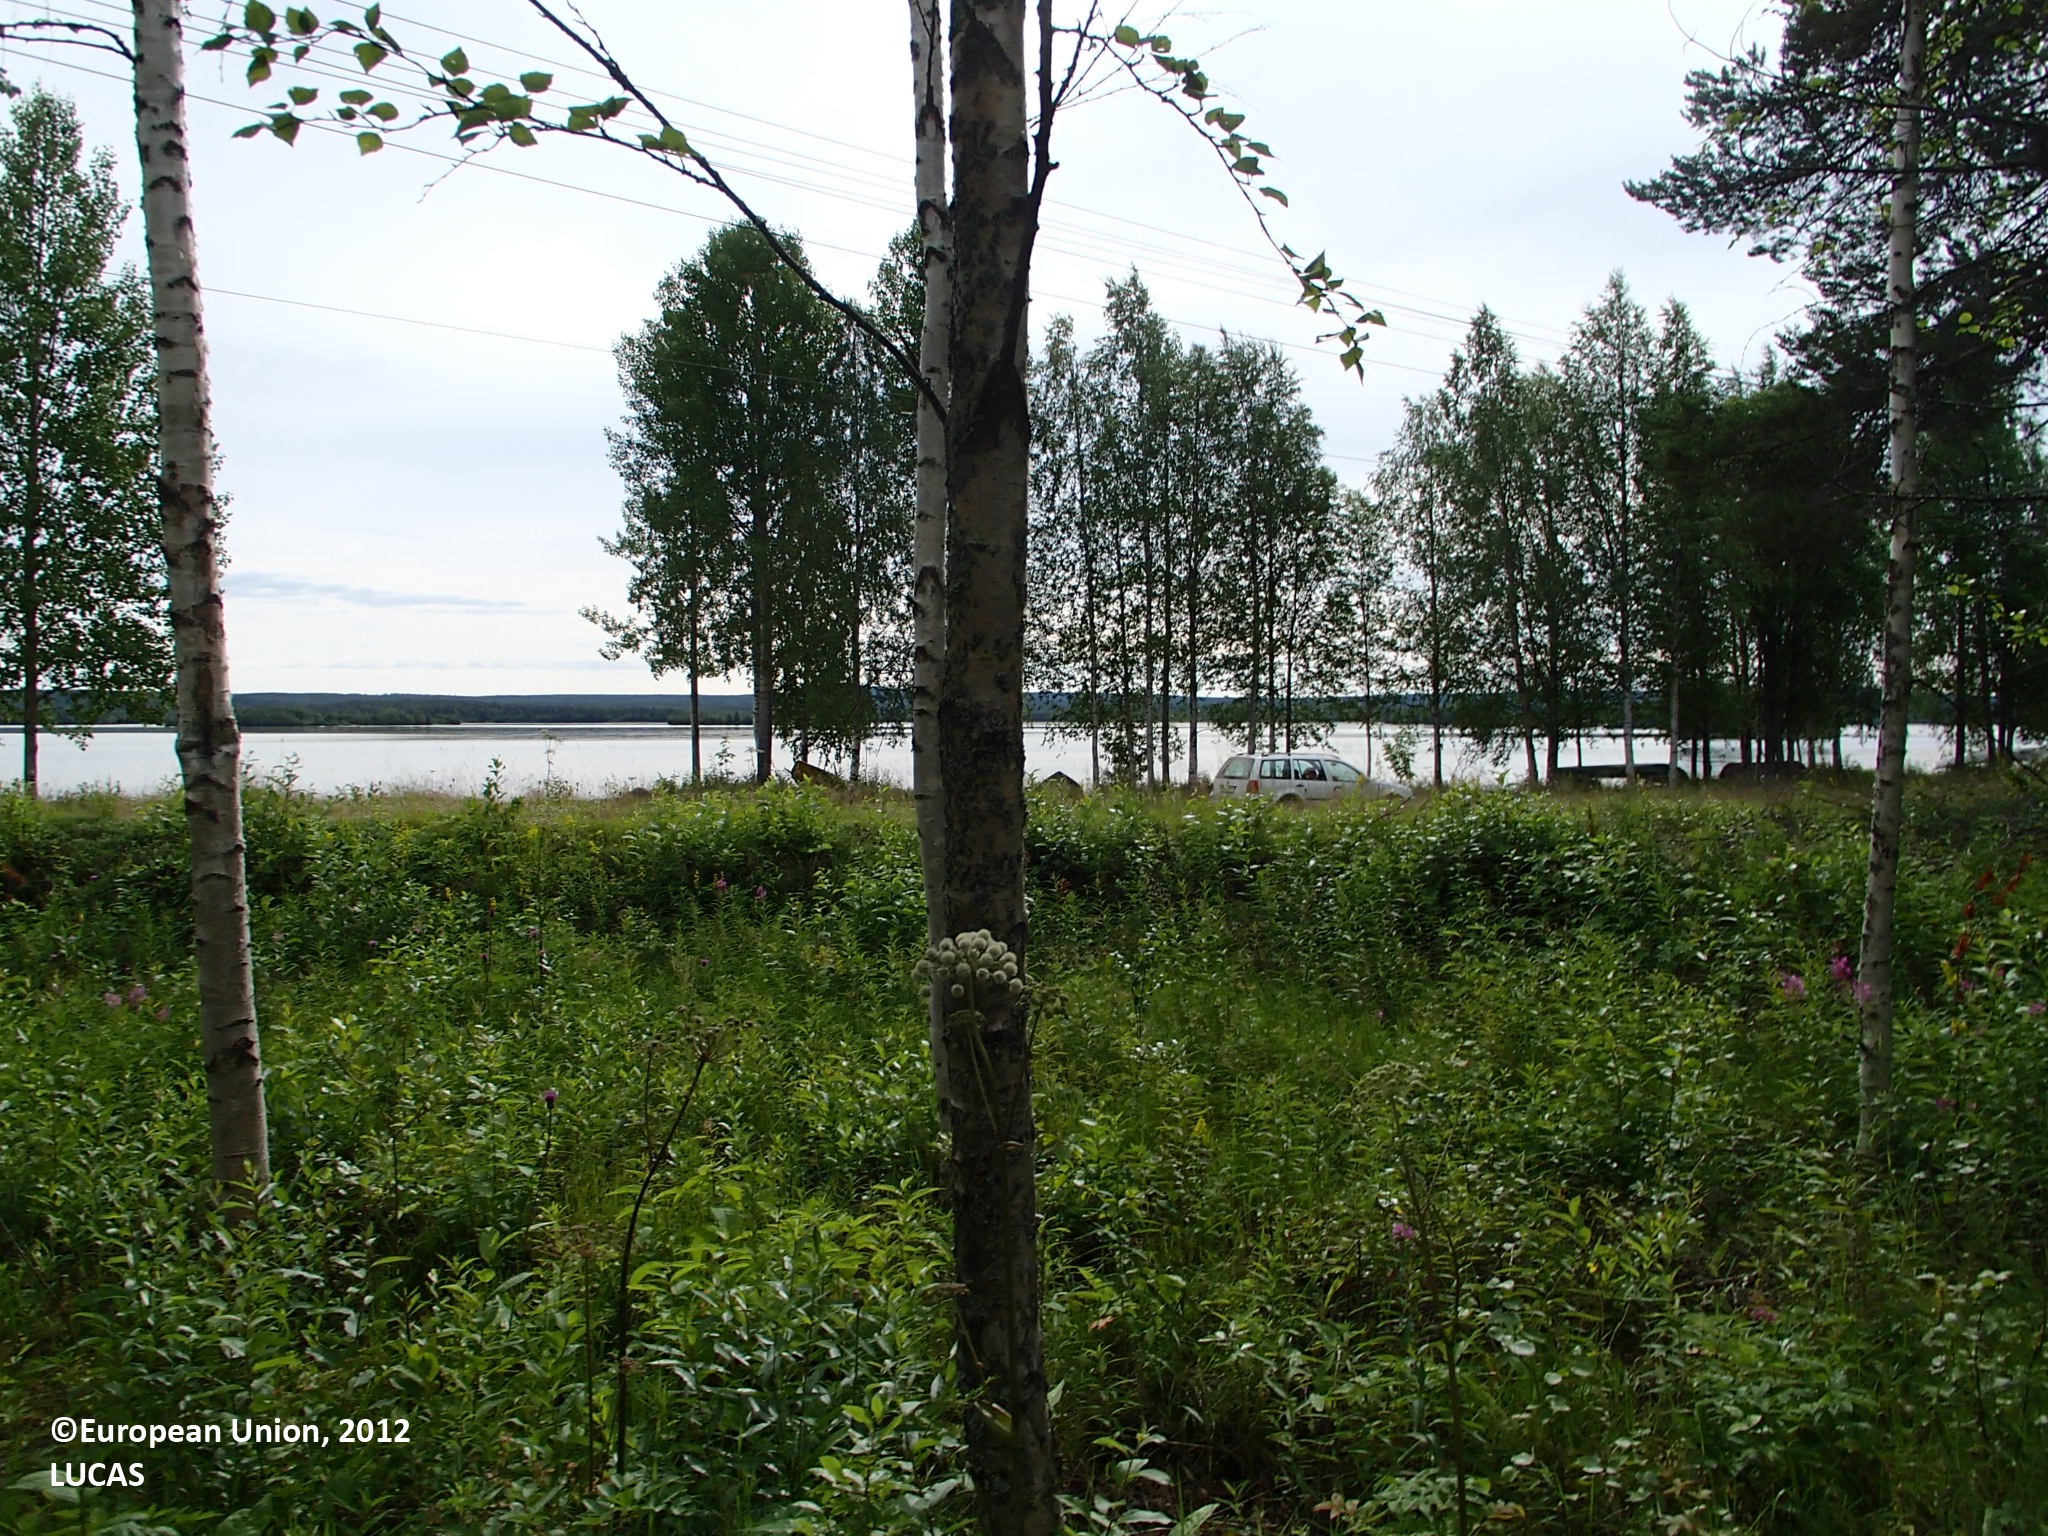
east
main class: Woodland
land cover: Broadleaved woodland
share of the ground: > 75 %
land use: Forestry
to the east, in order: Broadleaved woodland; Ditches and canals; Paved roads, cycling and walking lanes; Electric lines; Paved roads, cycling and walking lanes; Grassland without tree/shrub cover; Other bare soil; Inland running water
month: July
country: FI
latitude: 66.3800
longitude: 25.3842
